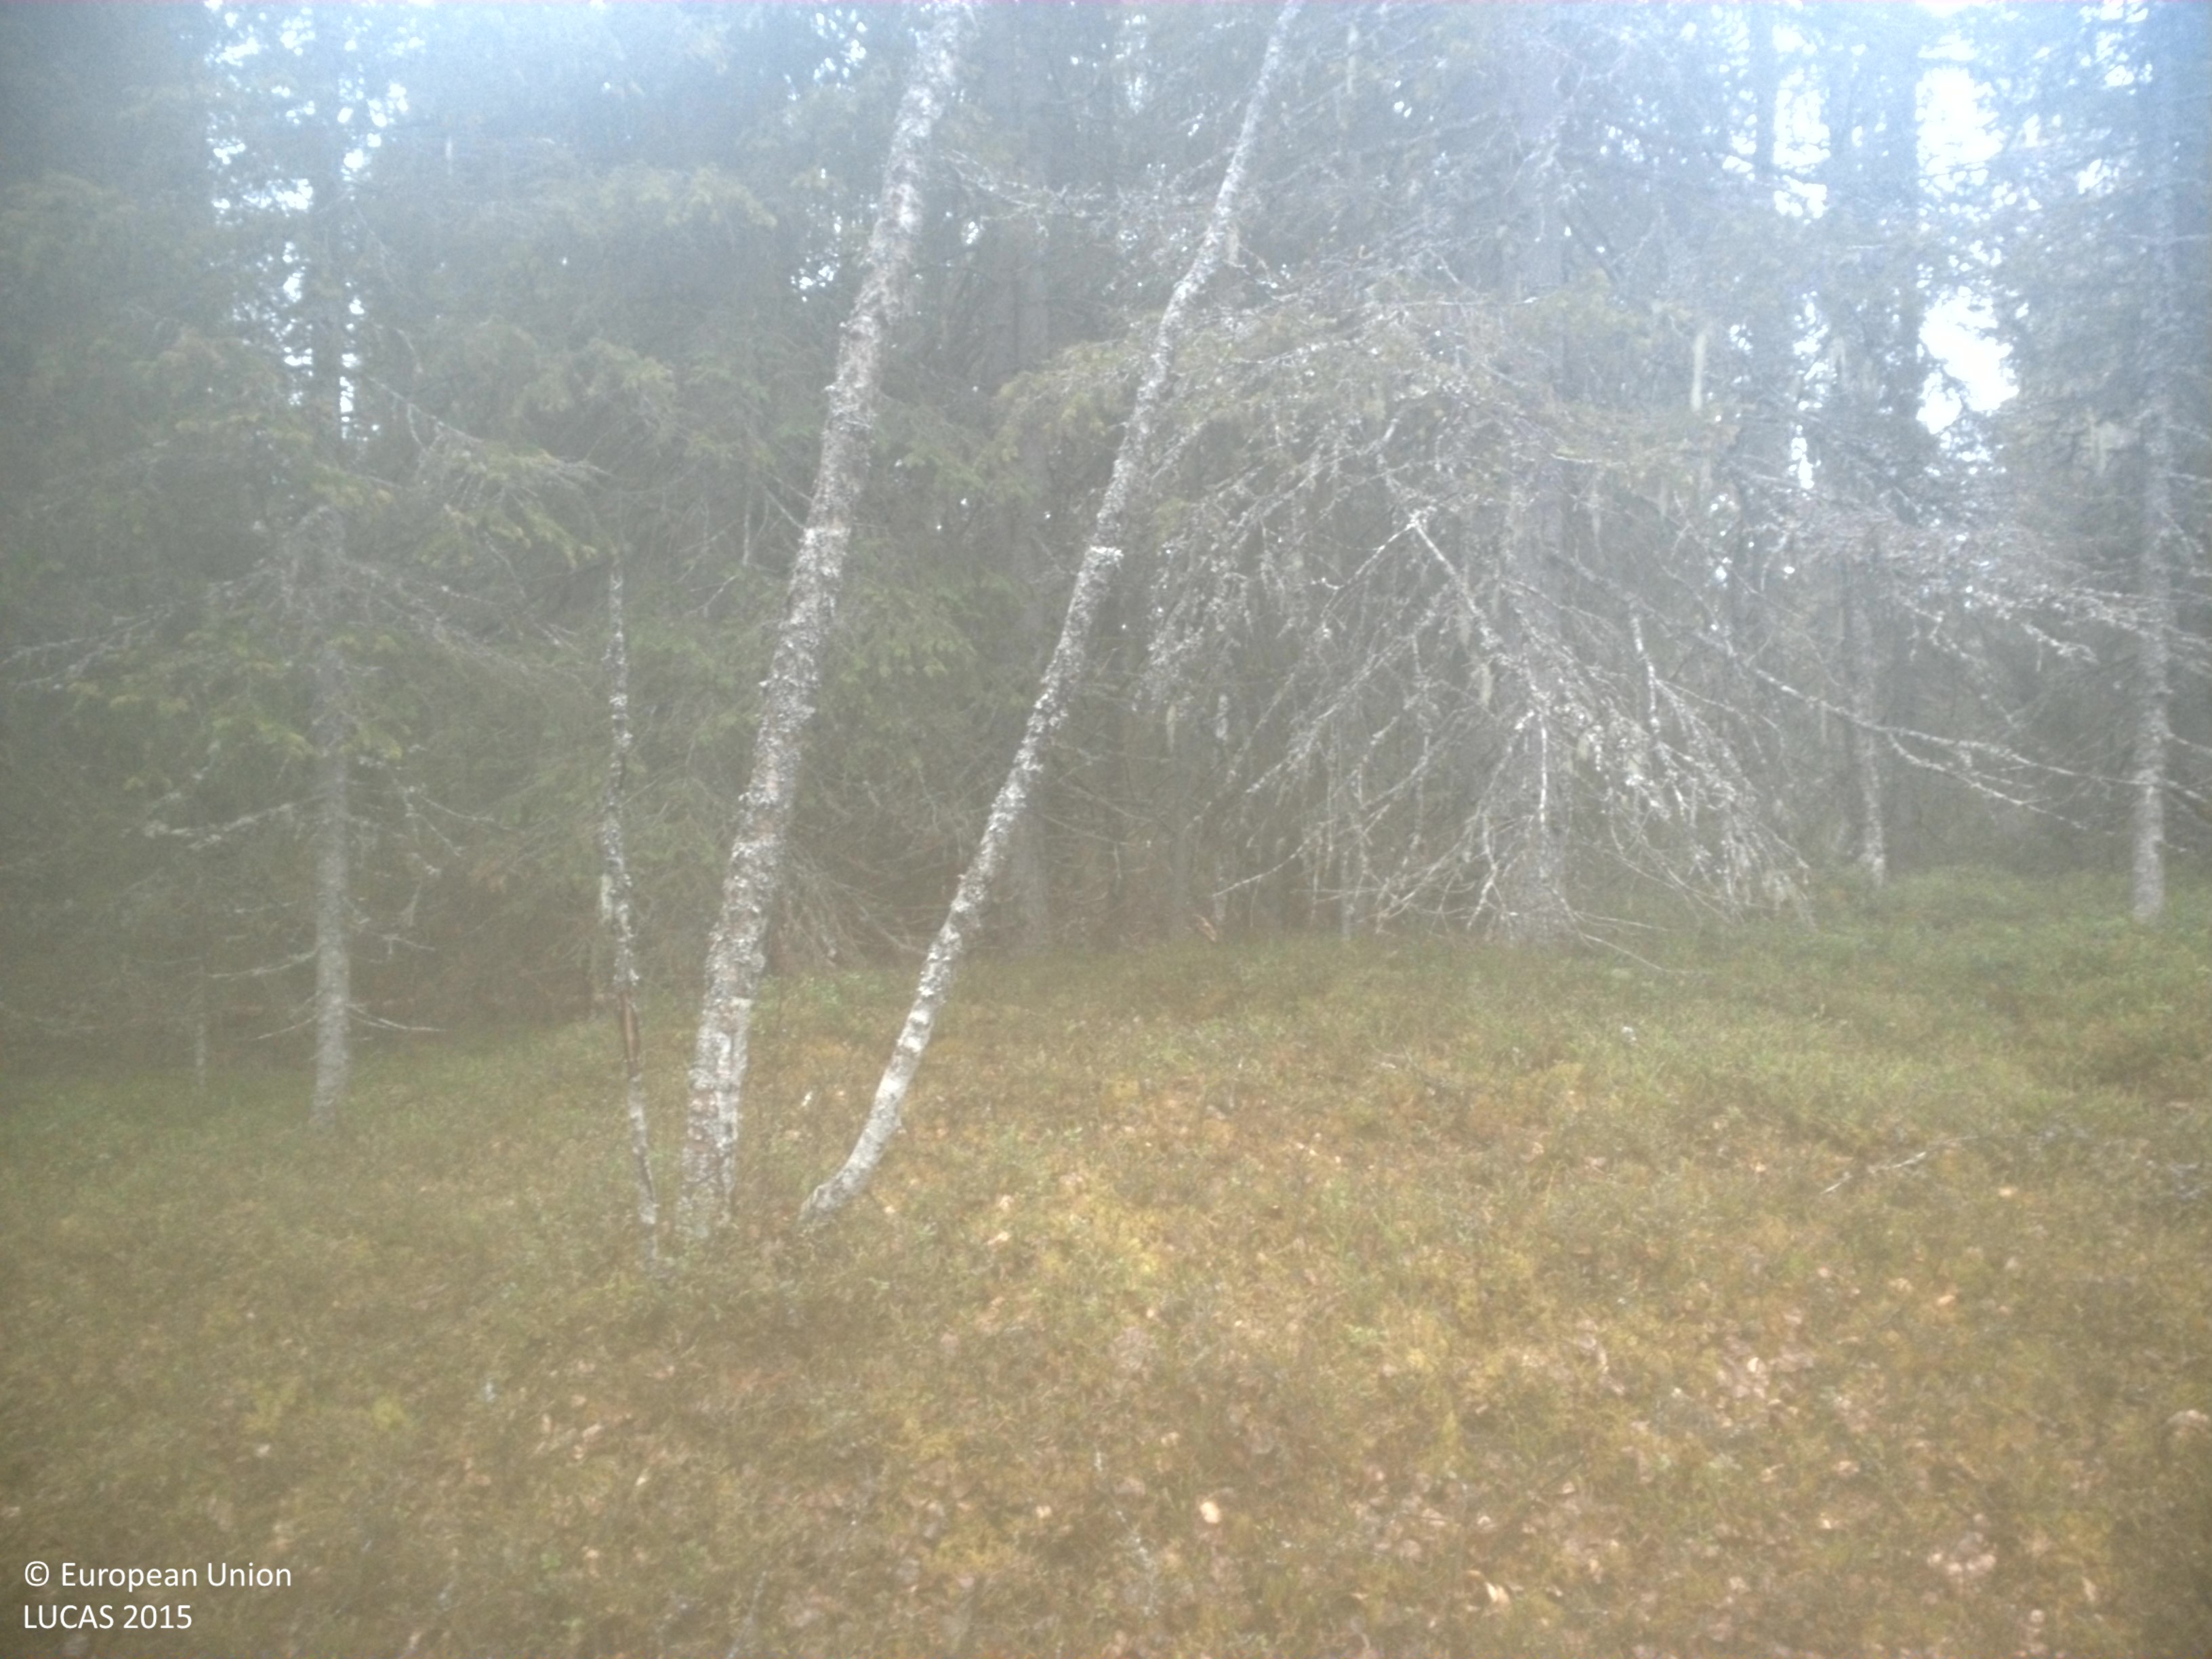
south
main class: Woodland
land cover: Spruce dominated coniferous woodland
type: boreal forest
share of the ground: 50 - 75 %
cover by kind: coniferous forest trees 50 %, herbaceous plants 20 %, lichens and mosses 15 %, broadleaved forest trees 10 %, shrubs 5 %
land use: Forestry
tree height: > 5 m
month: June
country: SE
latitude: 64.3722
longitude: 18.1123
